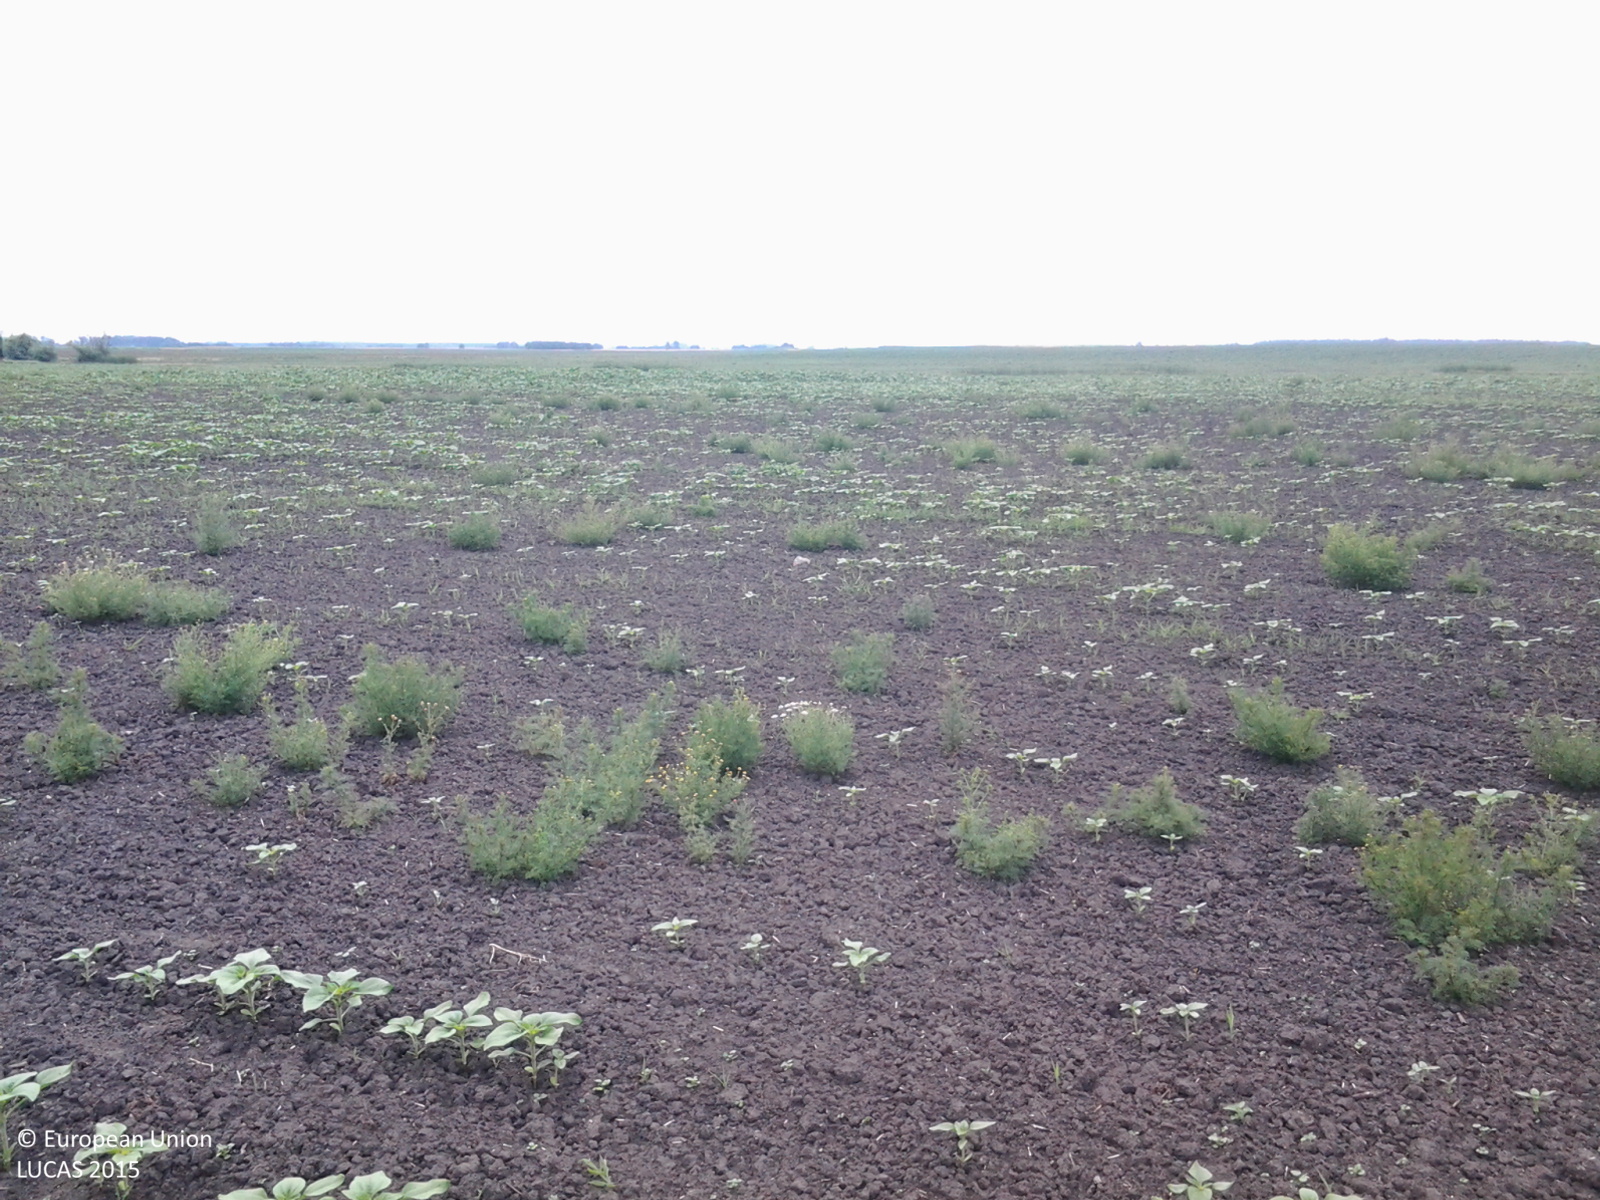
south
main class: Cropland
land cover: Sunflower
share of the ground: < 10 %
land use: Agriculture (excluding fallow land and kitchen gardens)
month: June
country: HU
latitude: 46.8210
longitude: 20.4215
